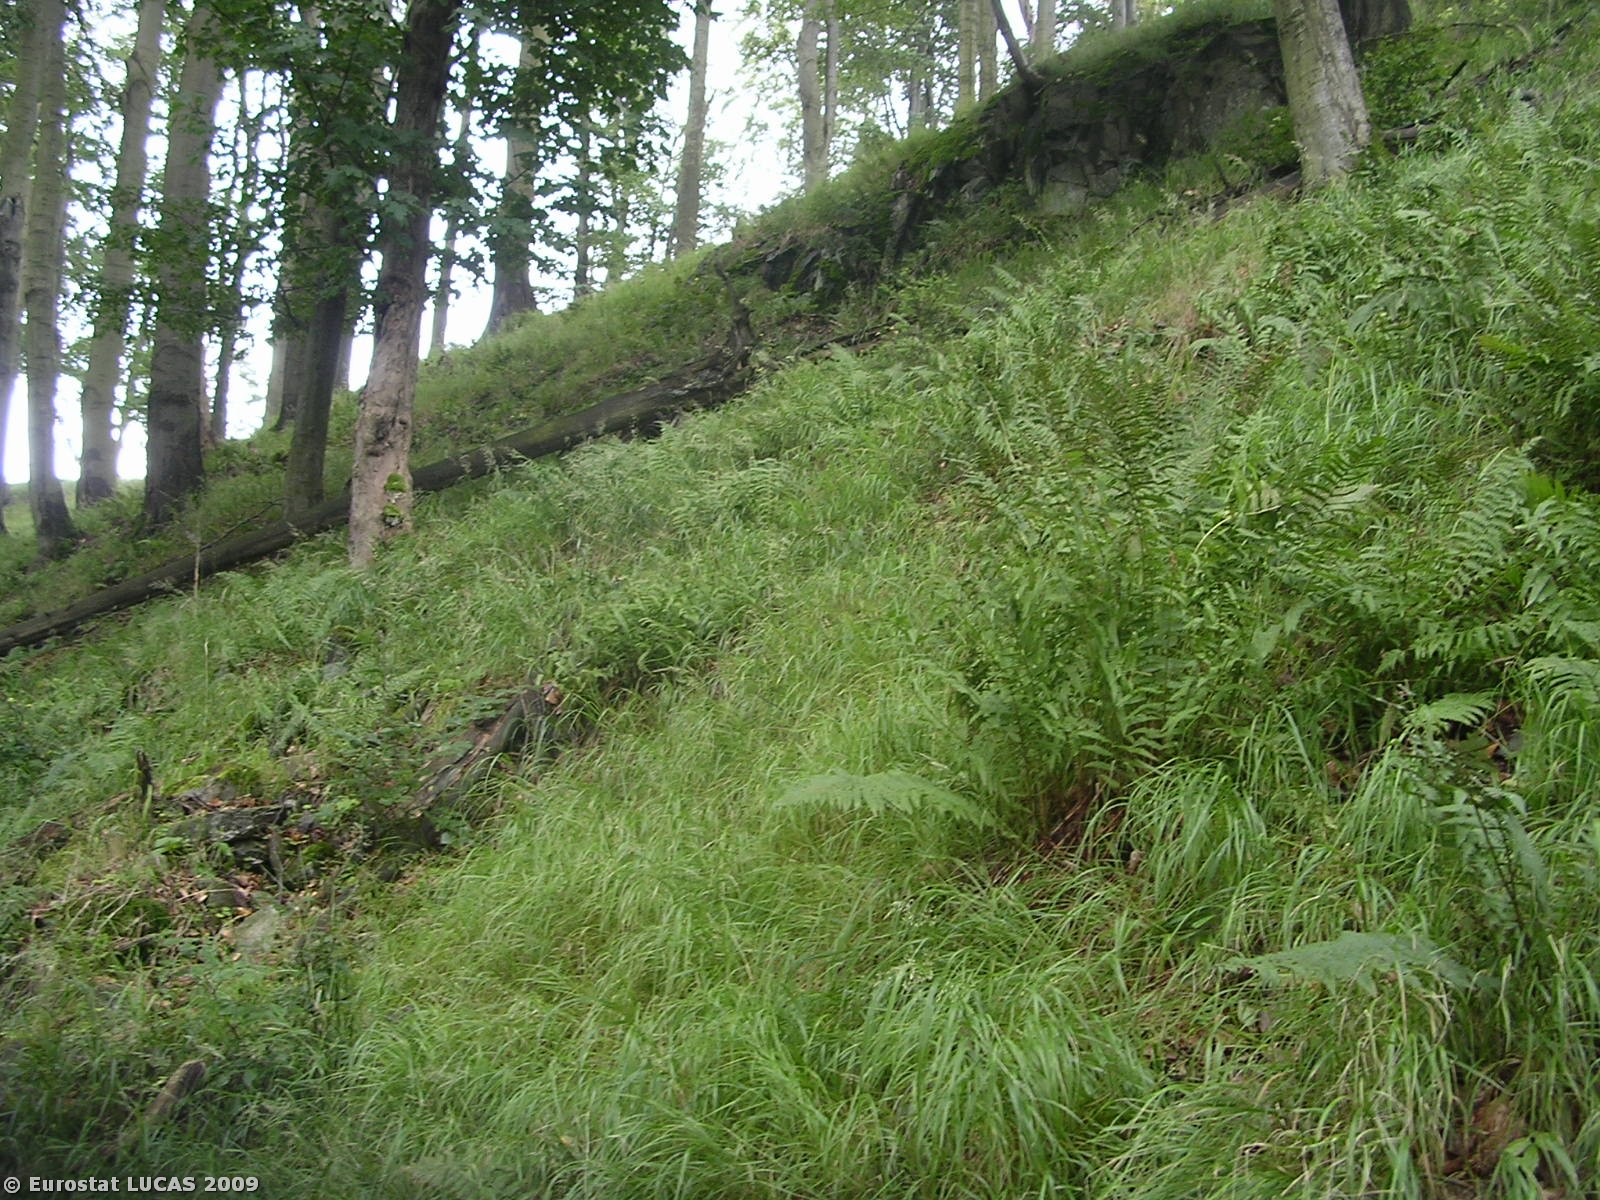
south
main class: Woodland
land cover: Broadleaved woodland
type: mountainous beech forest
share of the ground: > 75 %
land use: Forestry
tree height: > 5 m
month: July
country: CZ
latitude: 50.7956
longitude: 14.5561
